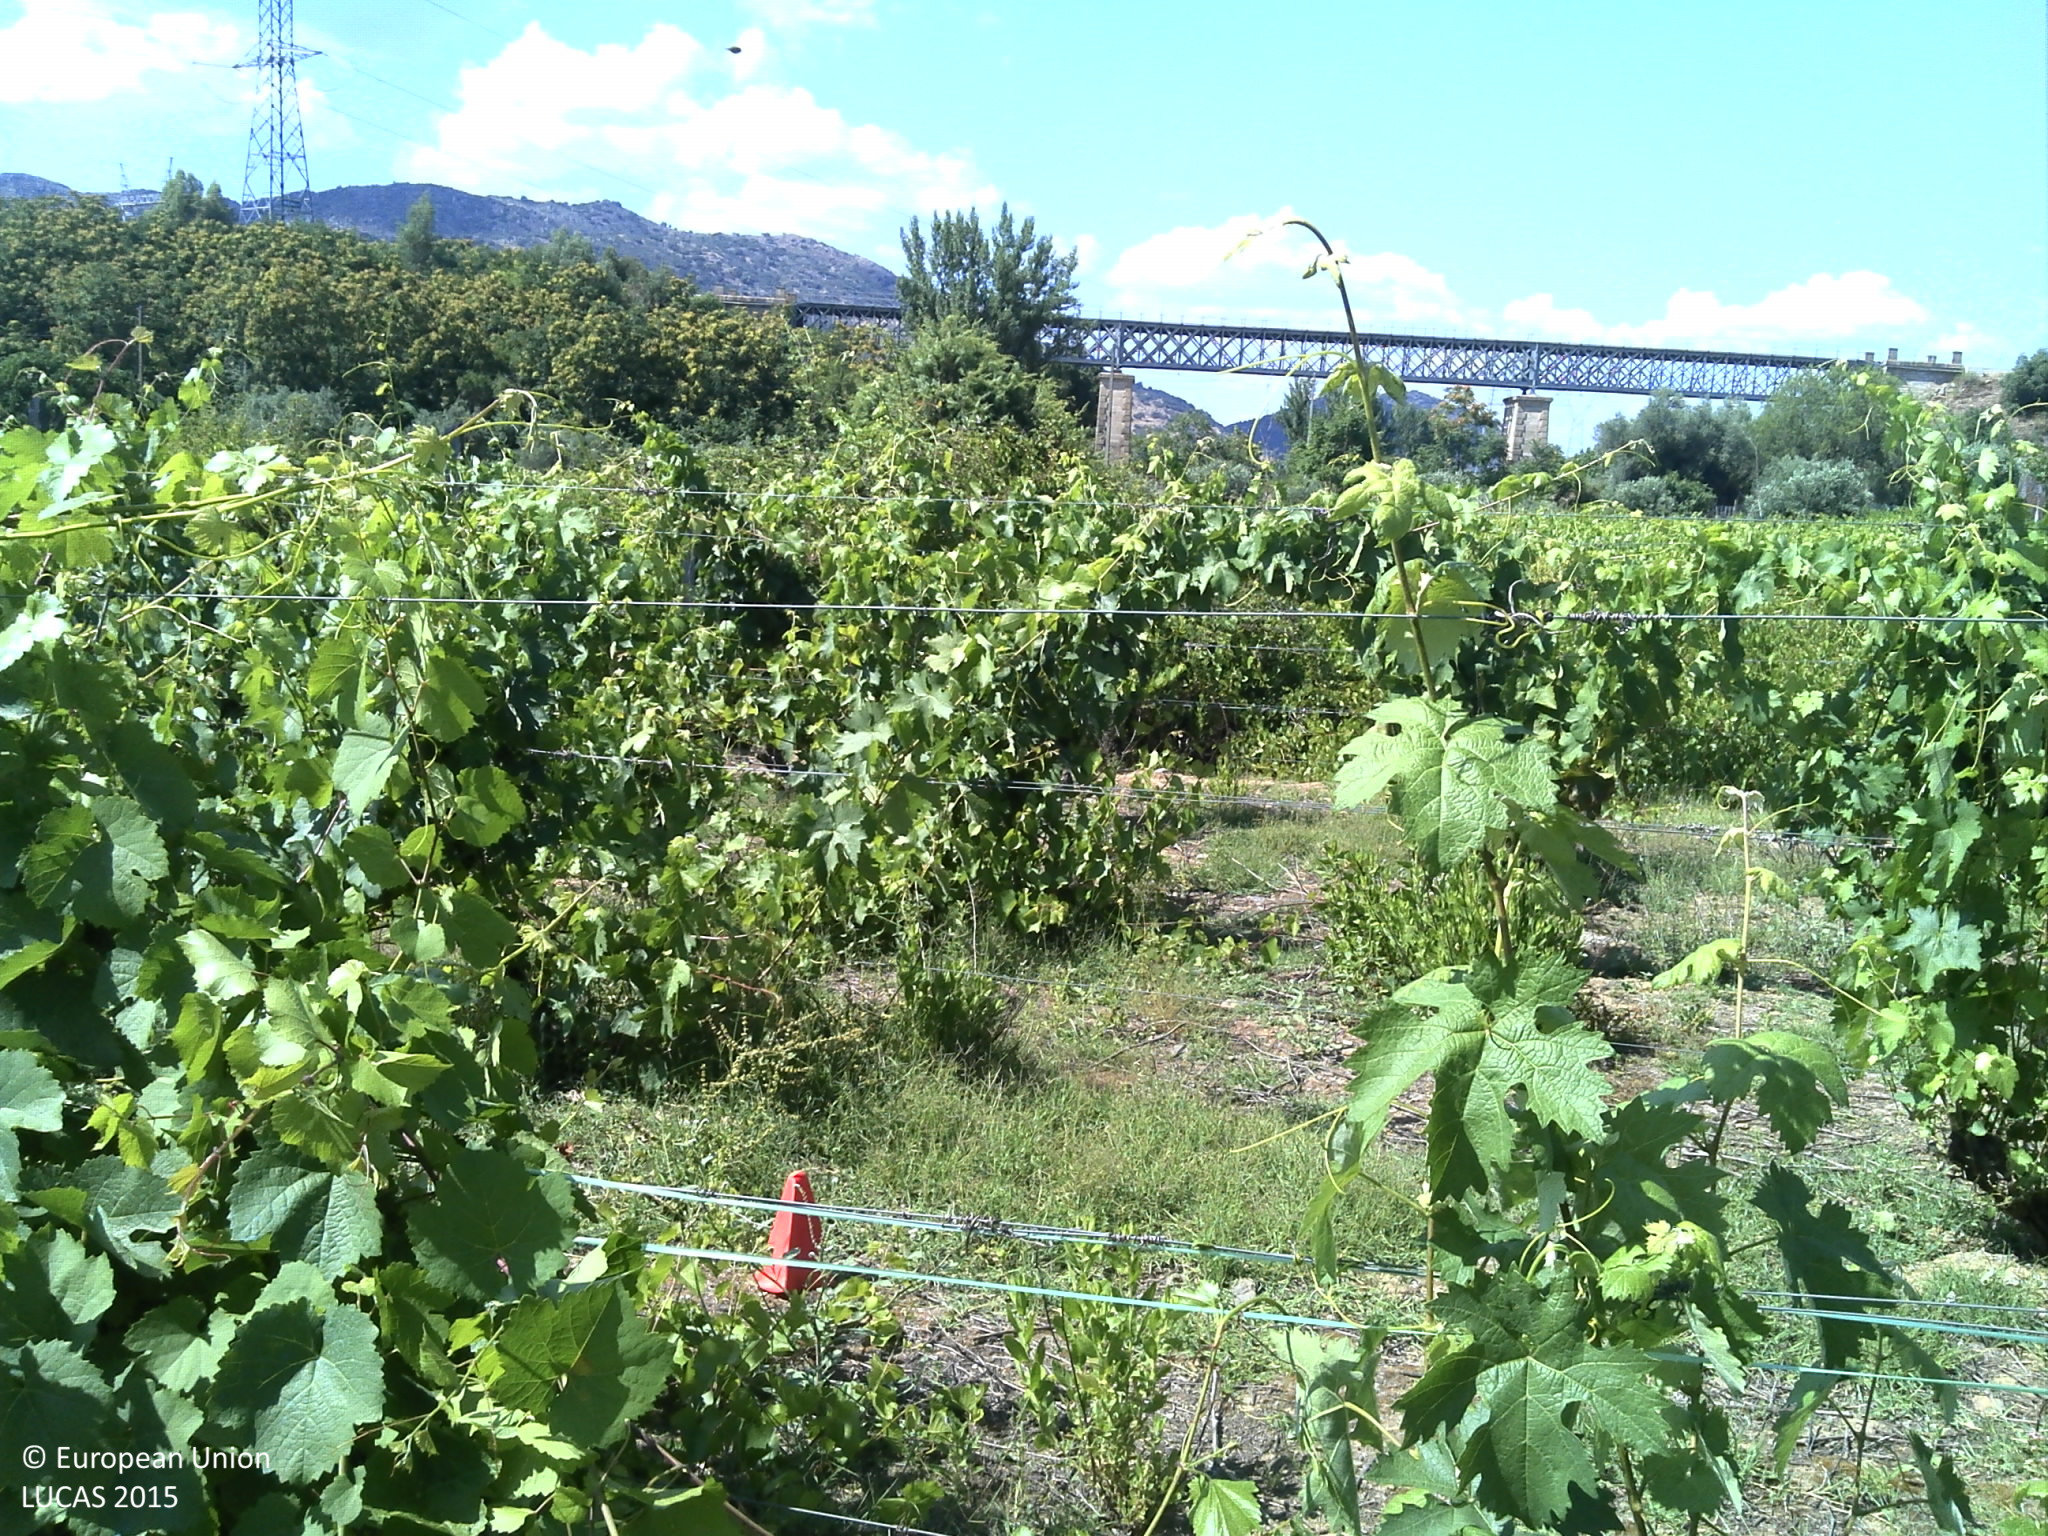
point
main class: Cropland
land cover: Vineyards
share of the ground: 25 - 50 %
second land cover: Grassland without tree/shrub cover
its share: 25 - 50 %
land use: Agriculture (excluding fallow land and kitchen gardens)
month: June
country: PT
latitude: 41.1260
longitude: -7.1332
